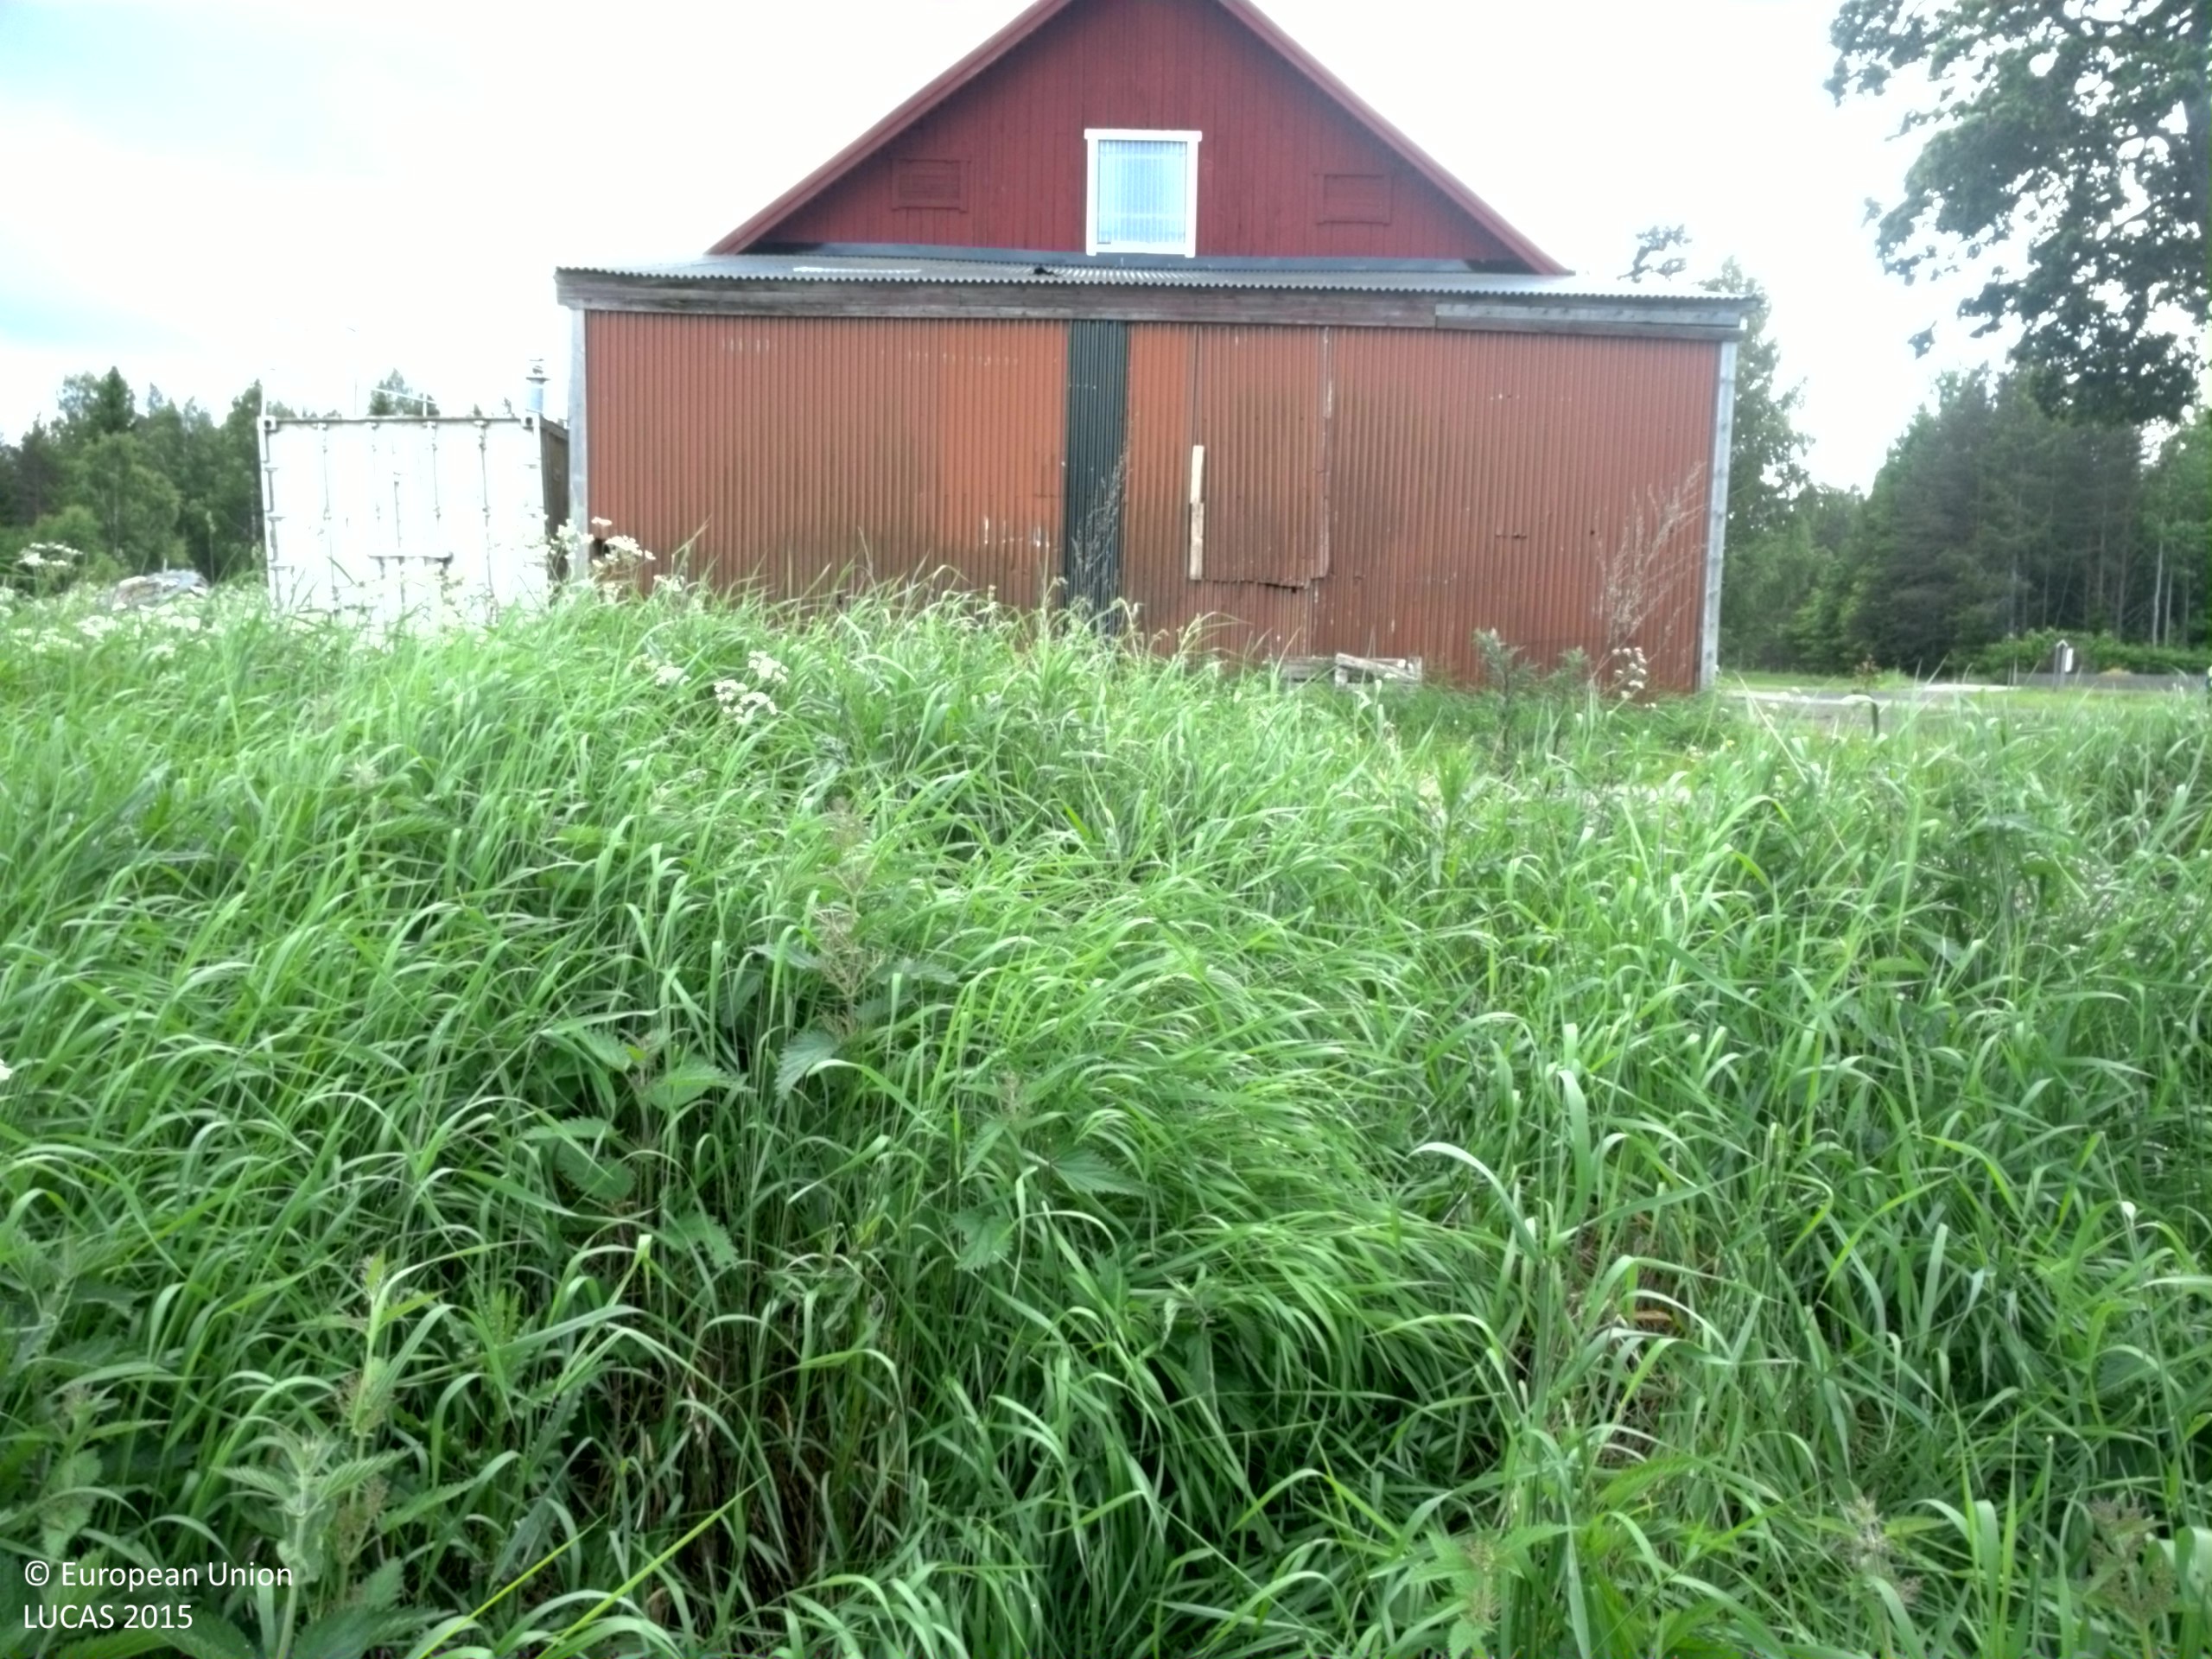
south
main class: Cropland
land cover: Common wheat
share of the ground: > 75 %
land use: Agriculture (excluding fallow land and kitchen gardens)
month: June
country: SE
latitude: 60.4279
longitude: 17.6028
